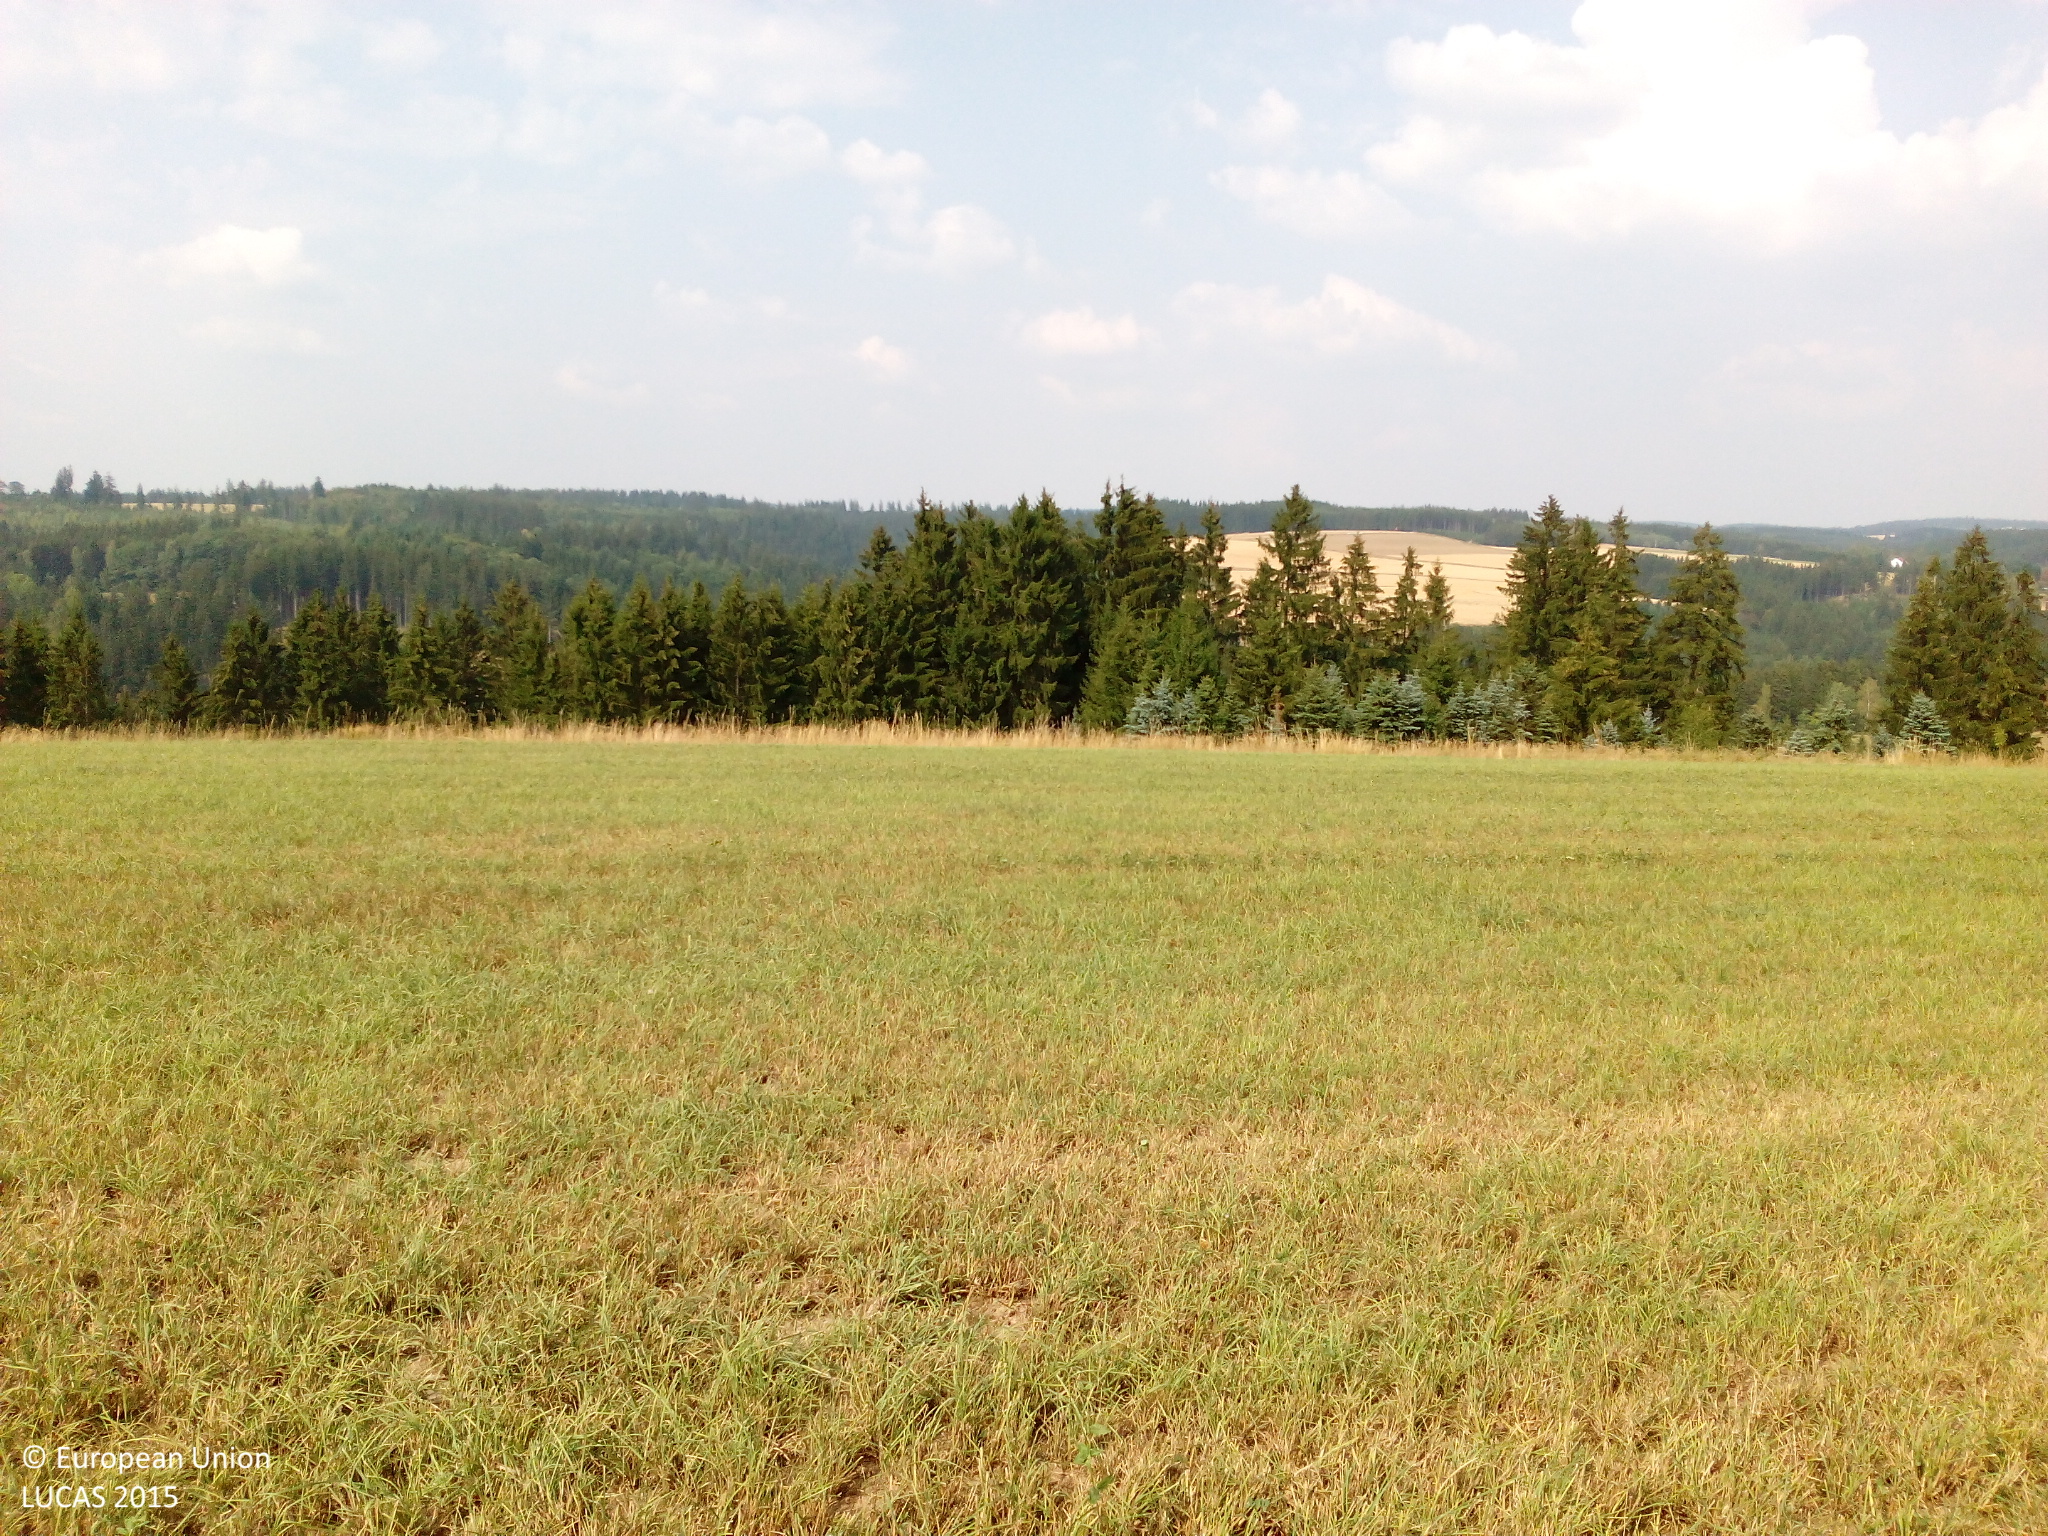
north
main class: Cropland
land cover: Temporary grasslands
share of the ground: 50 - 75 %
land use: Agriculture (excluding fallow land and kitchen gardens)
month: August
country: DE
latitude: 50.2632
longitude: 11.5848
